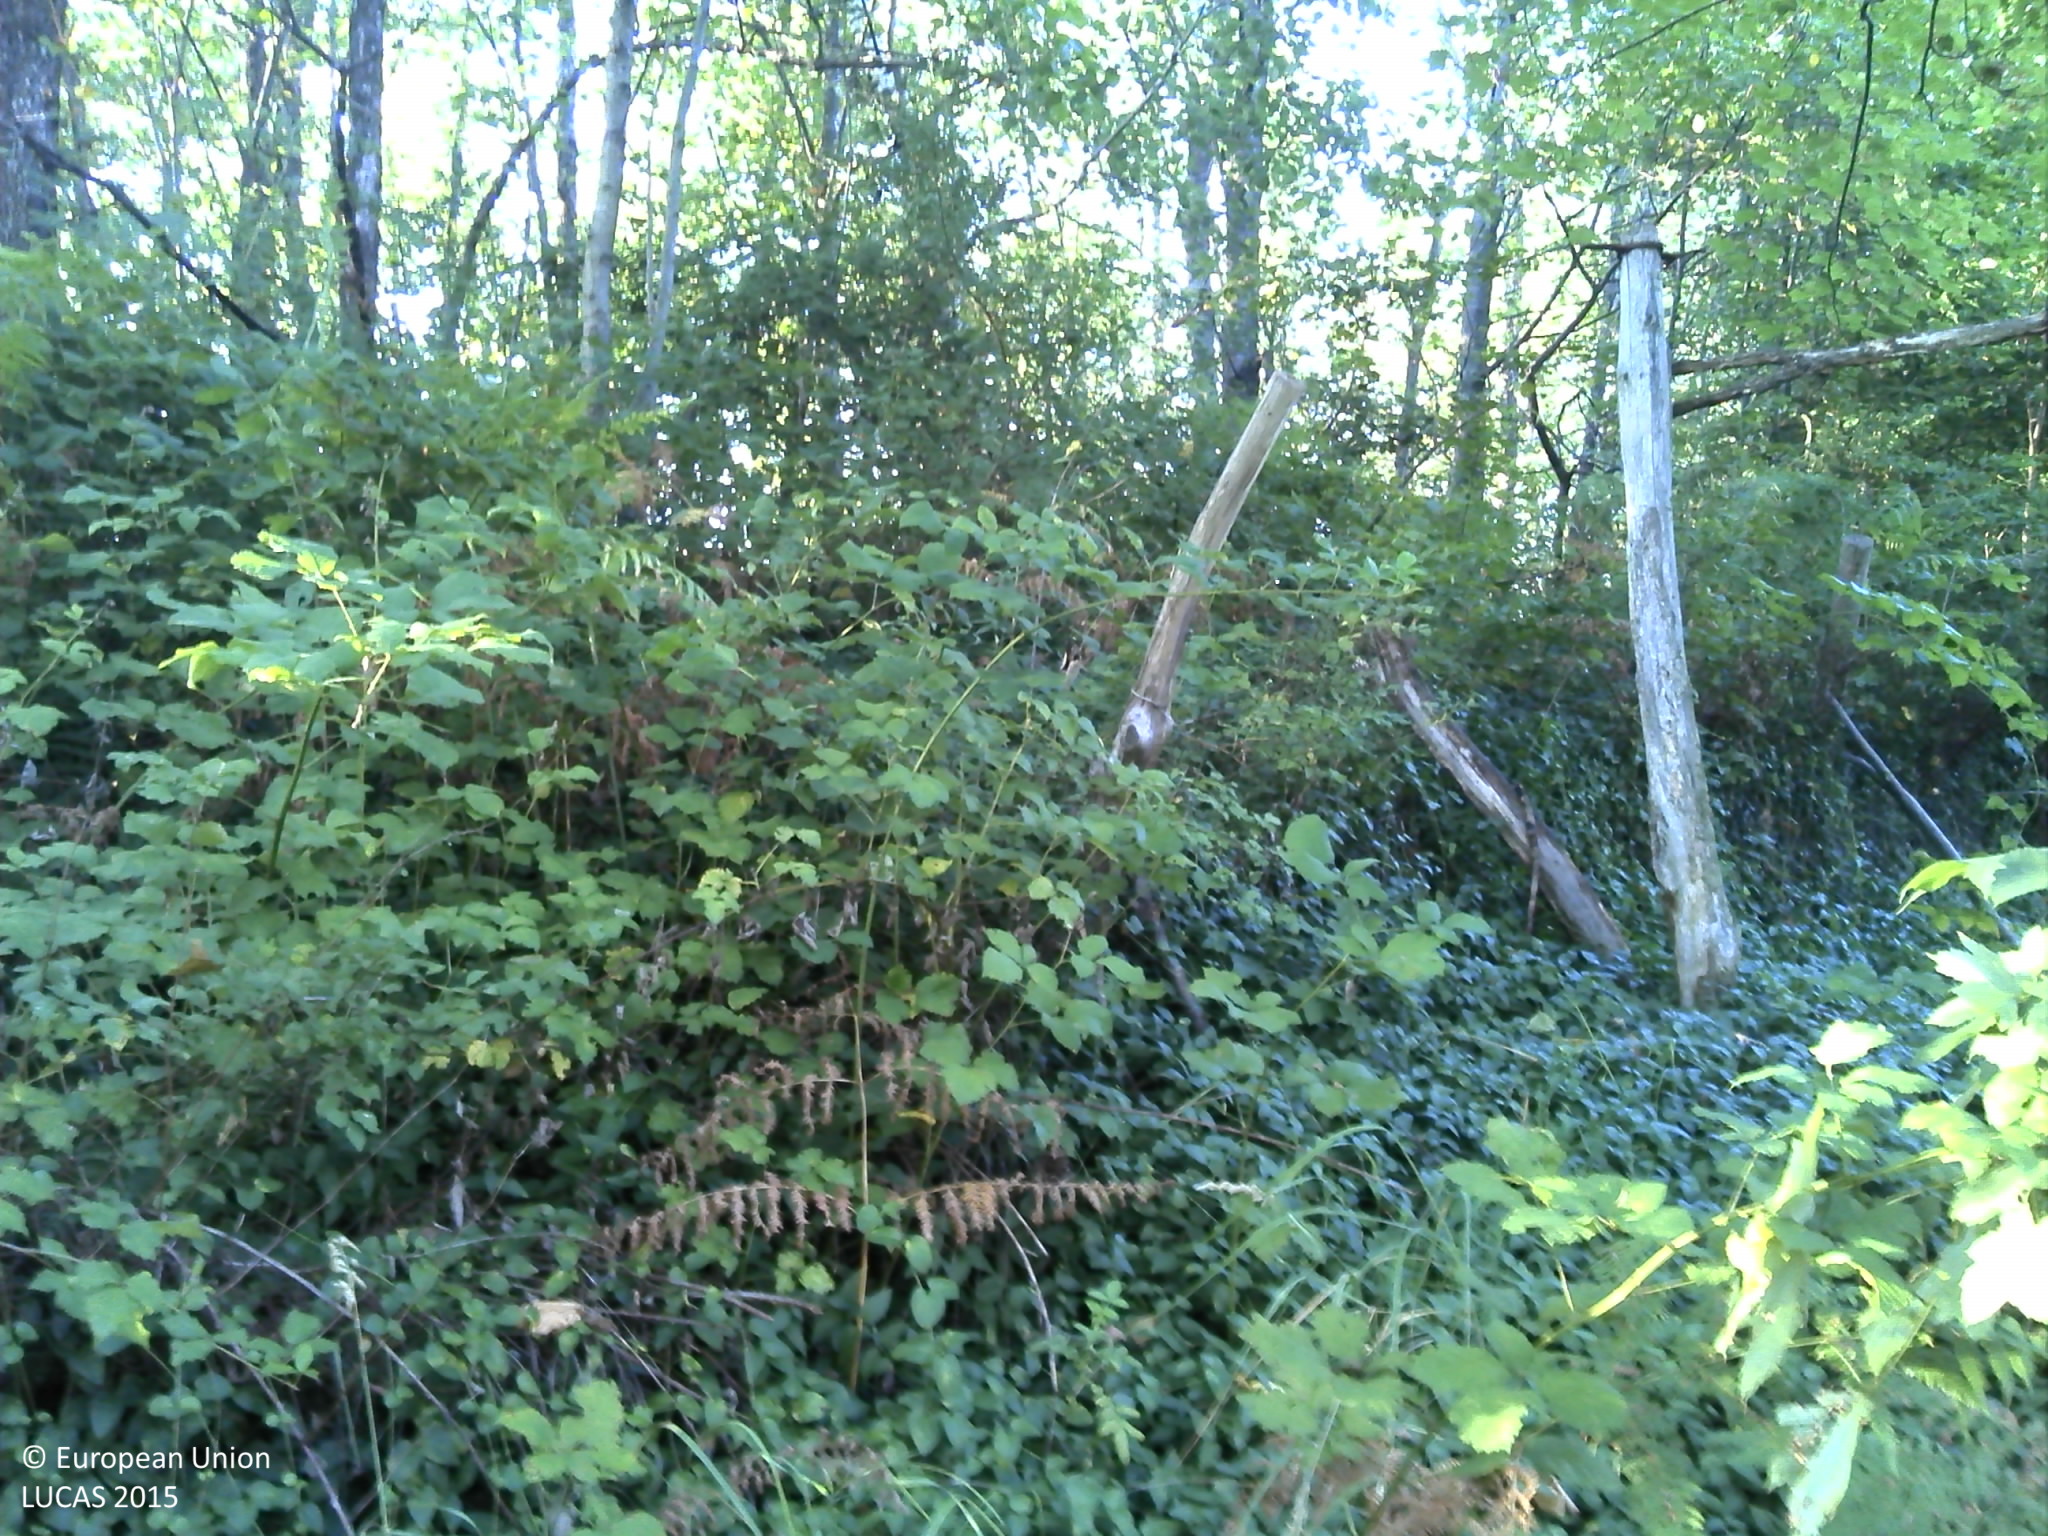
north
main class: Woodland
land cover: Broadleaved woodland
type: beech forest
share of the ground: > 75 %
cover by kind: broadleaved forest trees 100 %
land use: Forestry
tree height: > 5 m
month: August
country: HR
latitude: 45.3571
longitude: 15.9068
